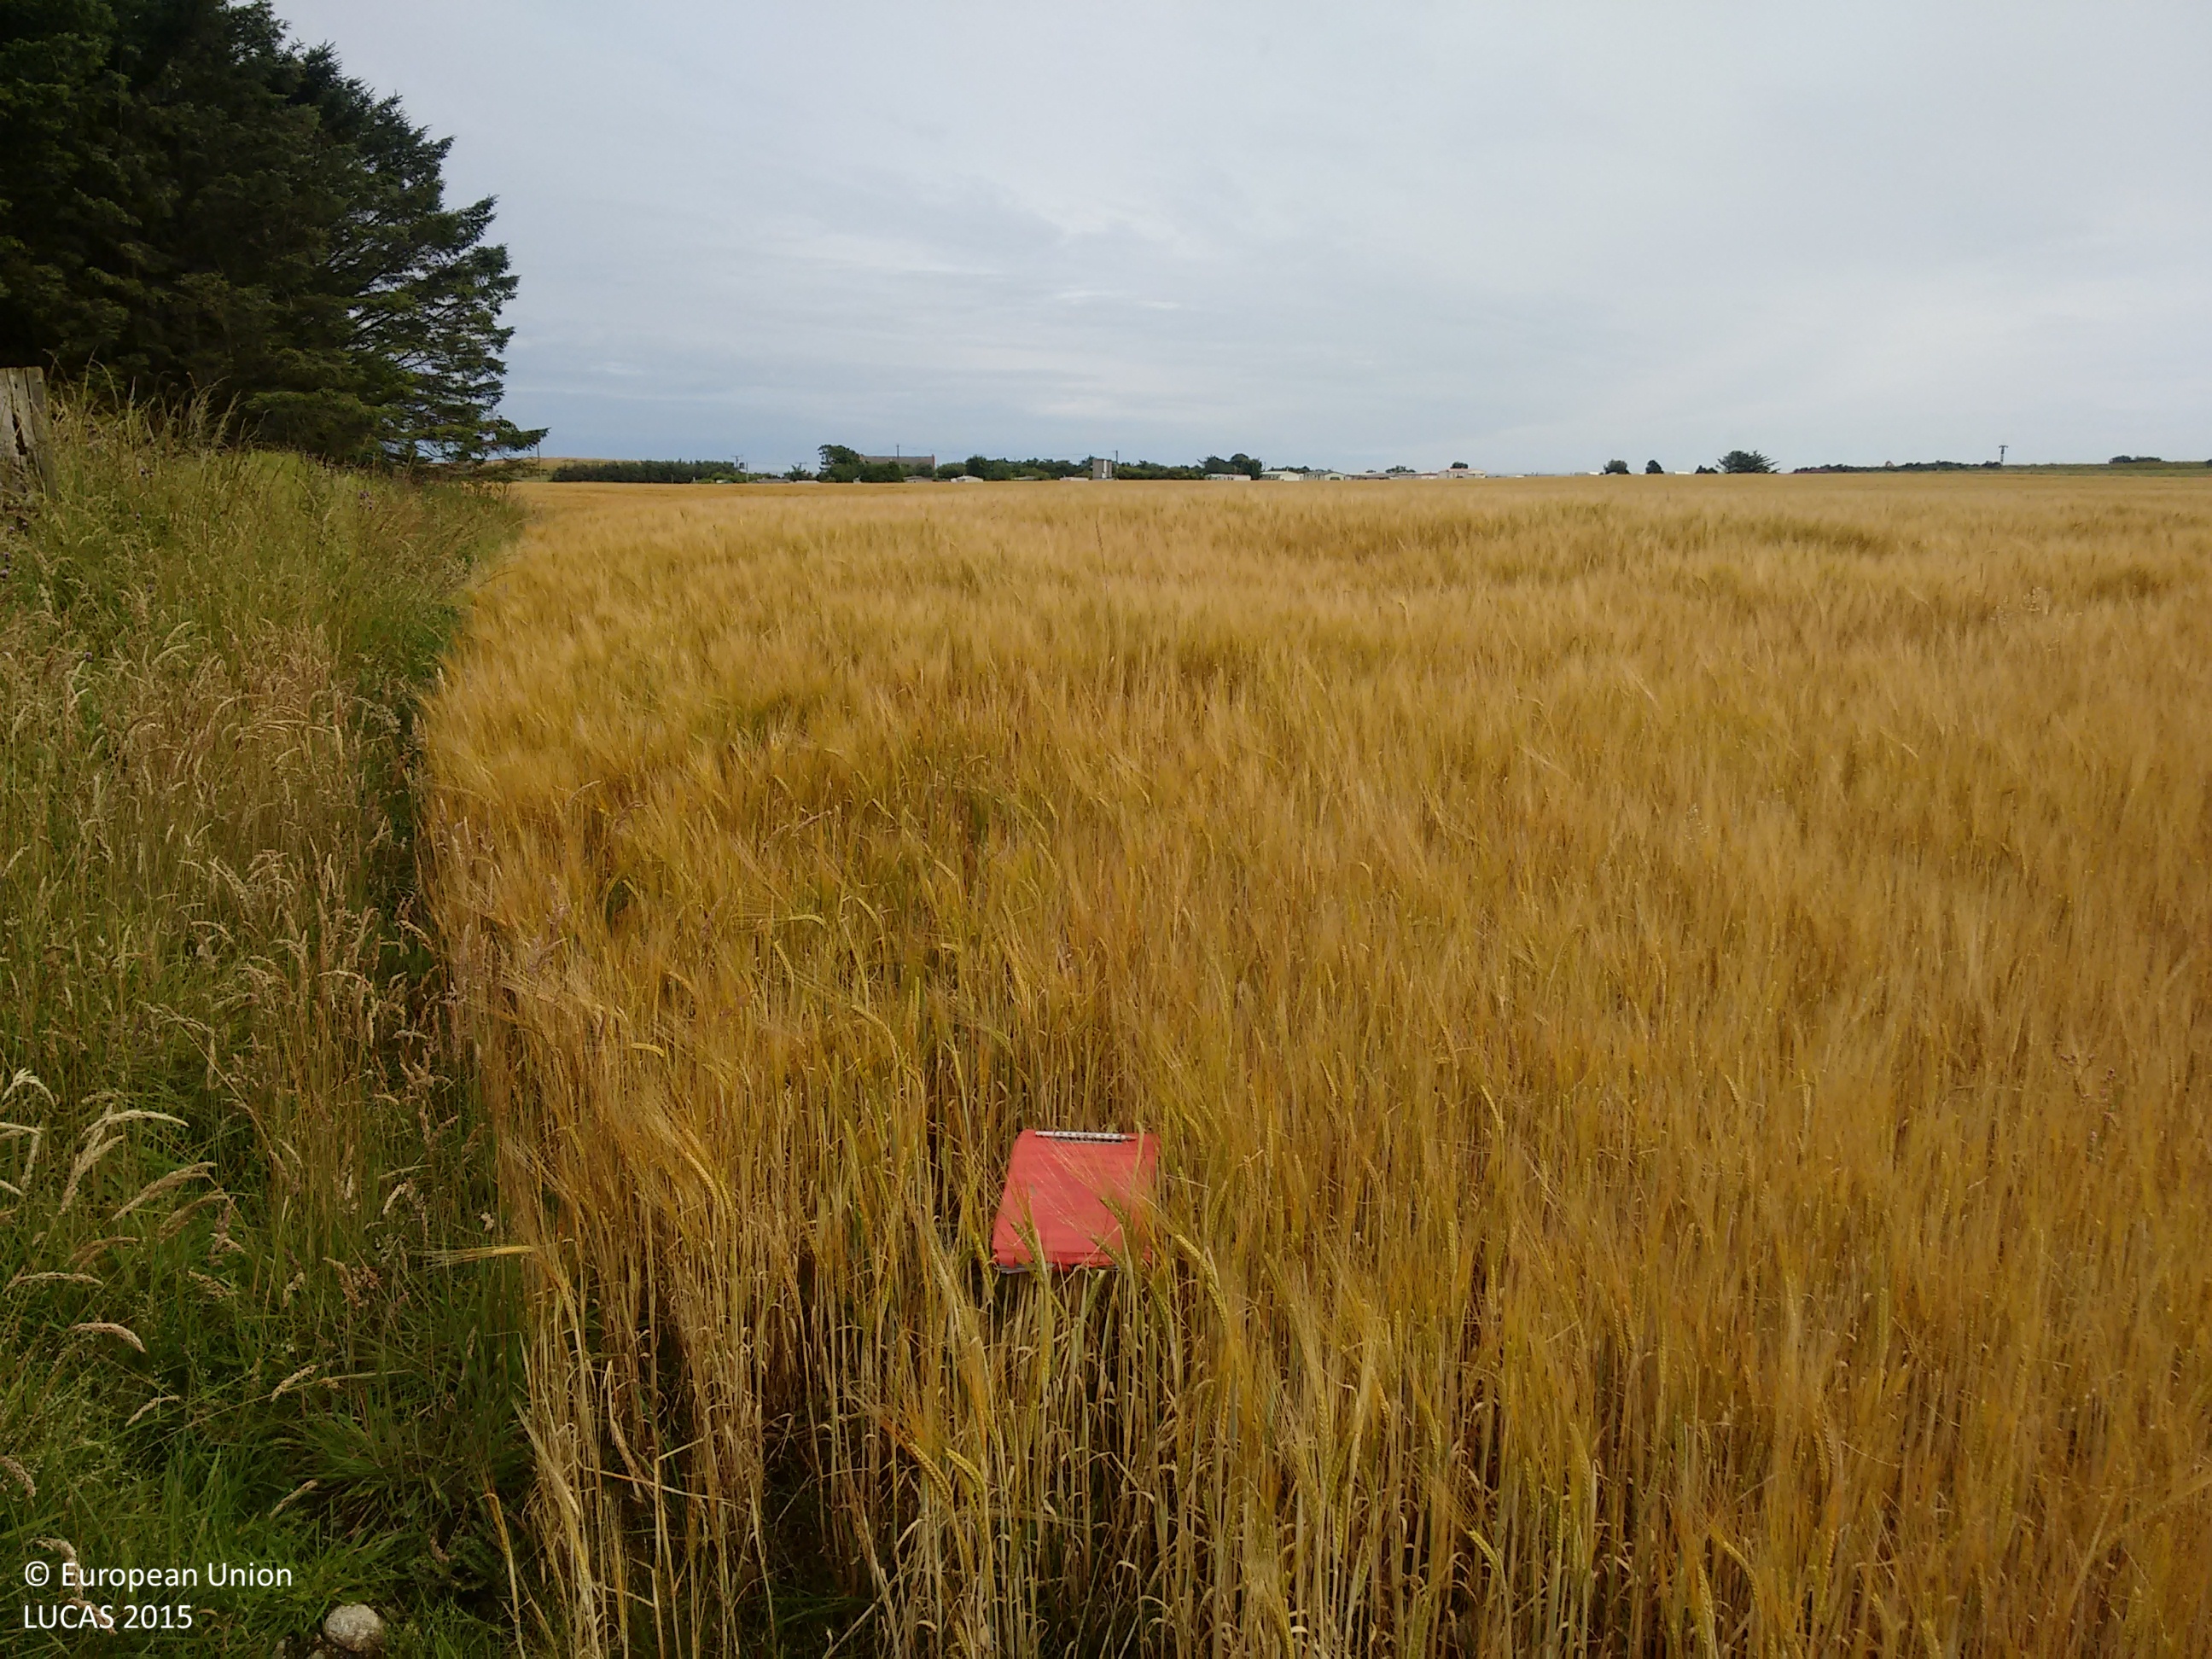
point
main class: Cropland
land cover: Barley
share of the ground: > 75 %
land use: Agriculture (excluding fallow land and kitchen gardens)
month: August
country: GB
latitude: 57.2163
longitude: -2.0860
